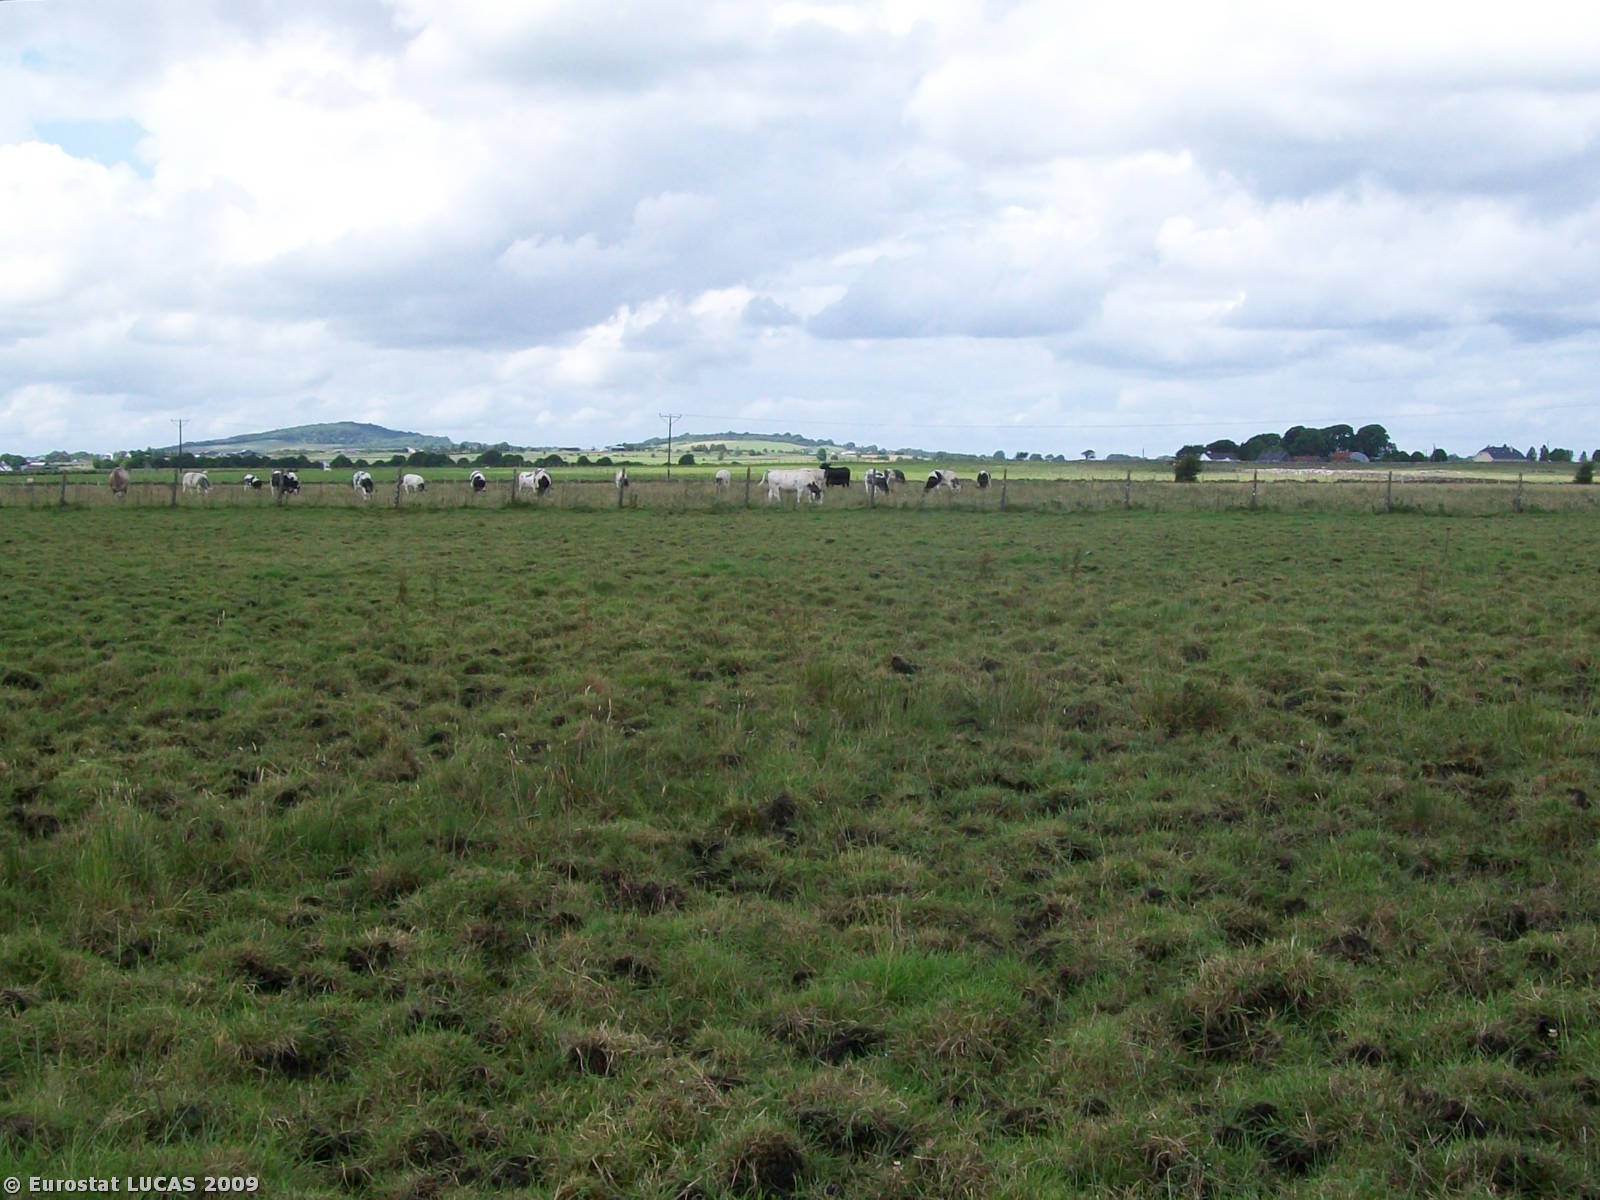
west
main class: Grassland
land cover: Grassland without tree/shrub cover
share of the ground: > 75 %
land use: Agriculture (excluding fallow land and kitchen gardens)
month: July
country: IE
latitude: 53.4701
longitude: -8.8728
